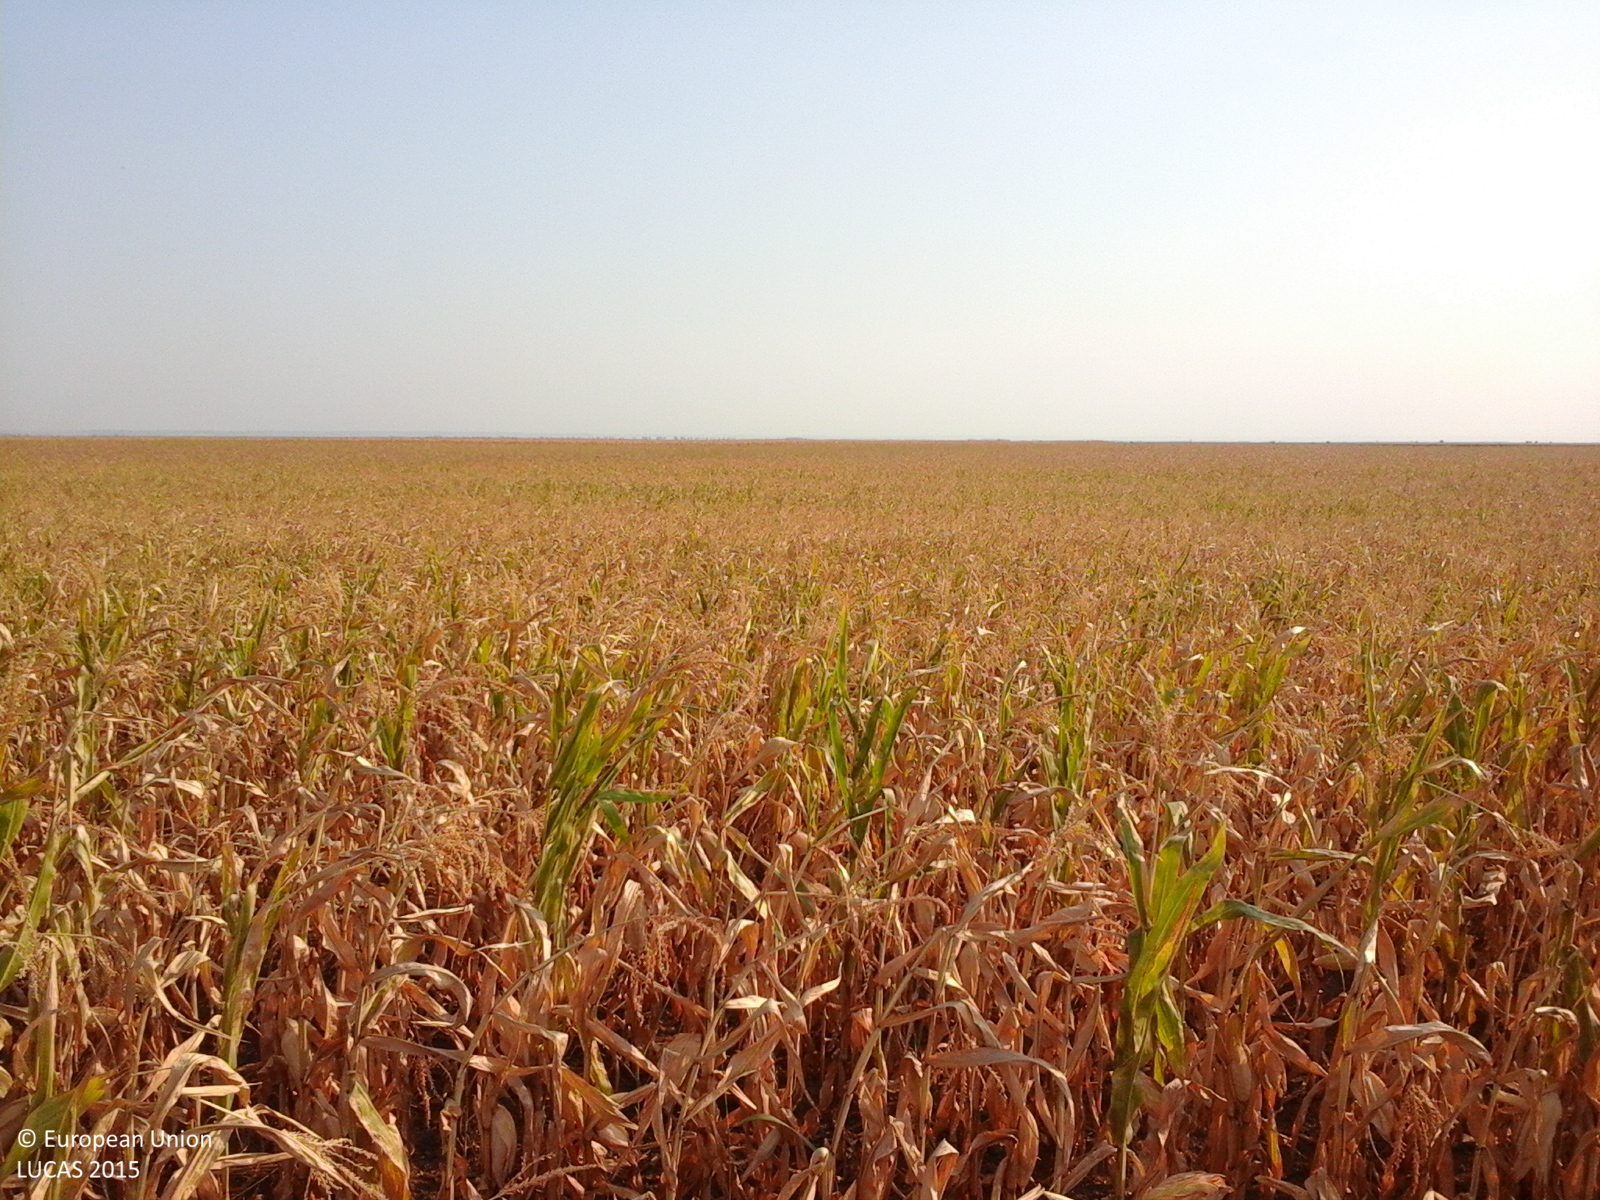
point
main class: Cropland
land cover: Maize
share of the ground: > 75 %
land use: Agriculture (excluding fallow land and kitchen gardens)
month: August
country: RO
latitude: 43.9992
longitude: 23.1757
